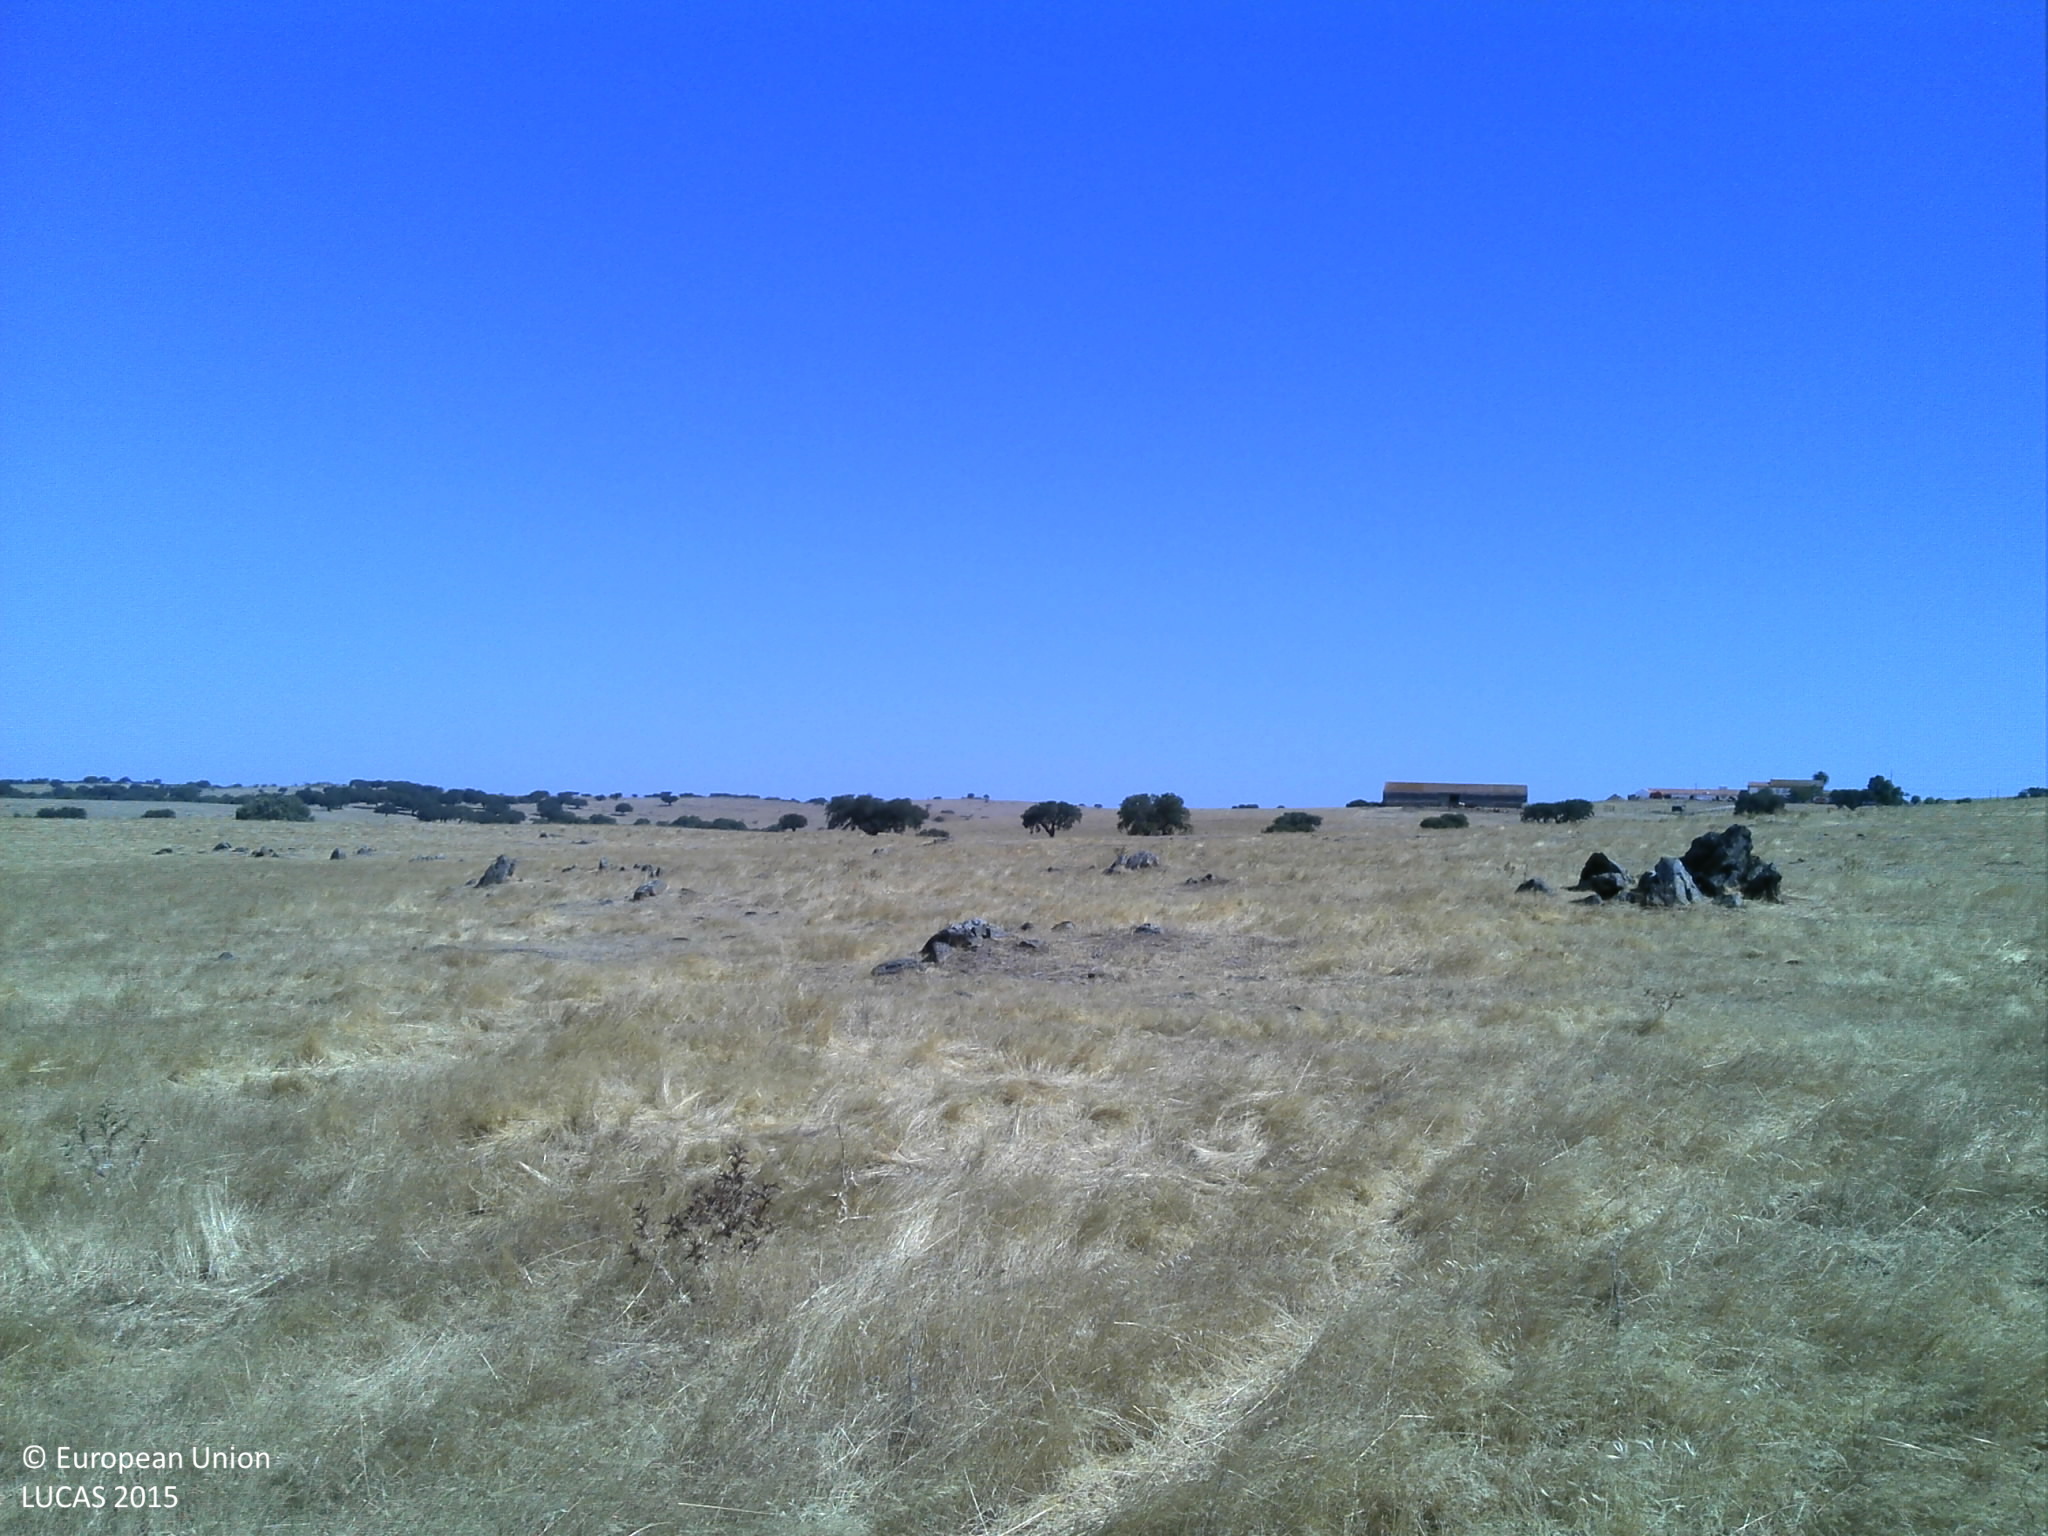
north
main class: Grassland
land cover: Grassland without tree/shrub cover
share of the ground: 50 - 75 %
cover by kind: herbaceous plants 60 %, unconsolidated bare surface 40 %
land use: Agriculture (excluding fallow land and kitchen gardens)
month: July
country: PT
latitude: 39.1195
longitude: -7.4221
